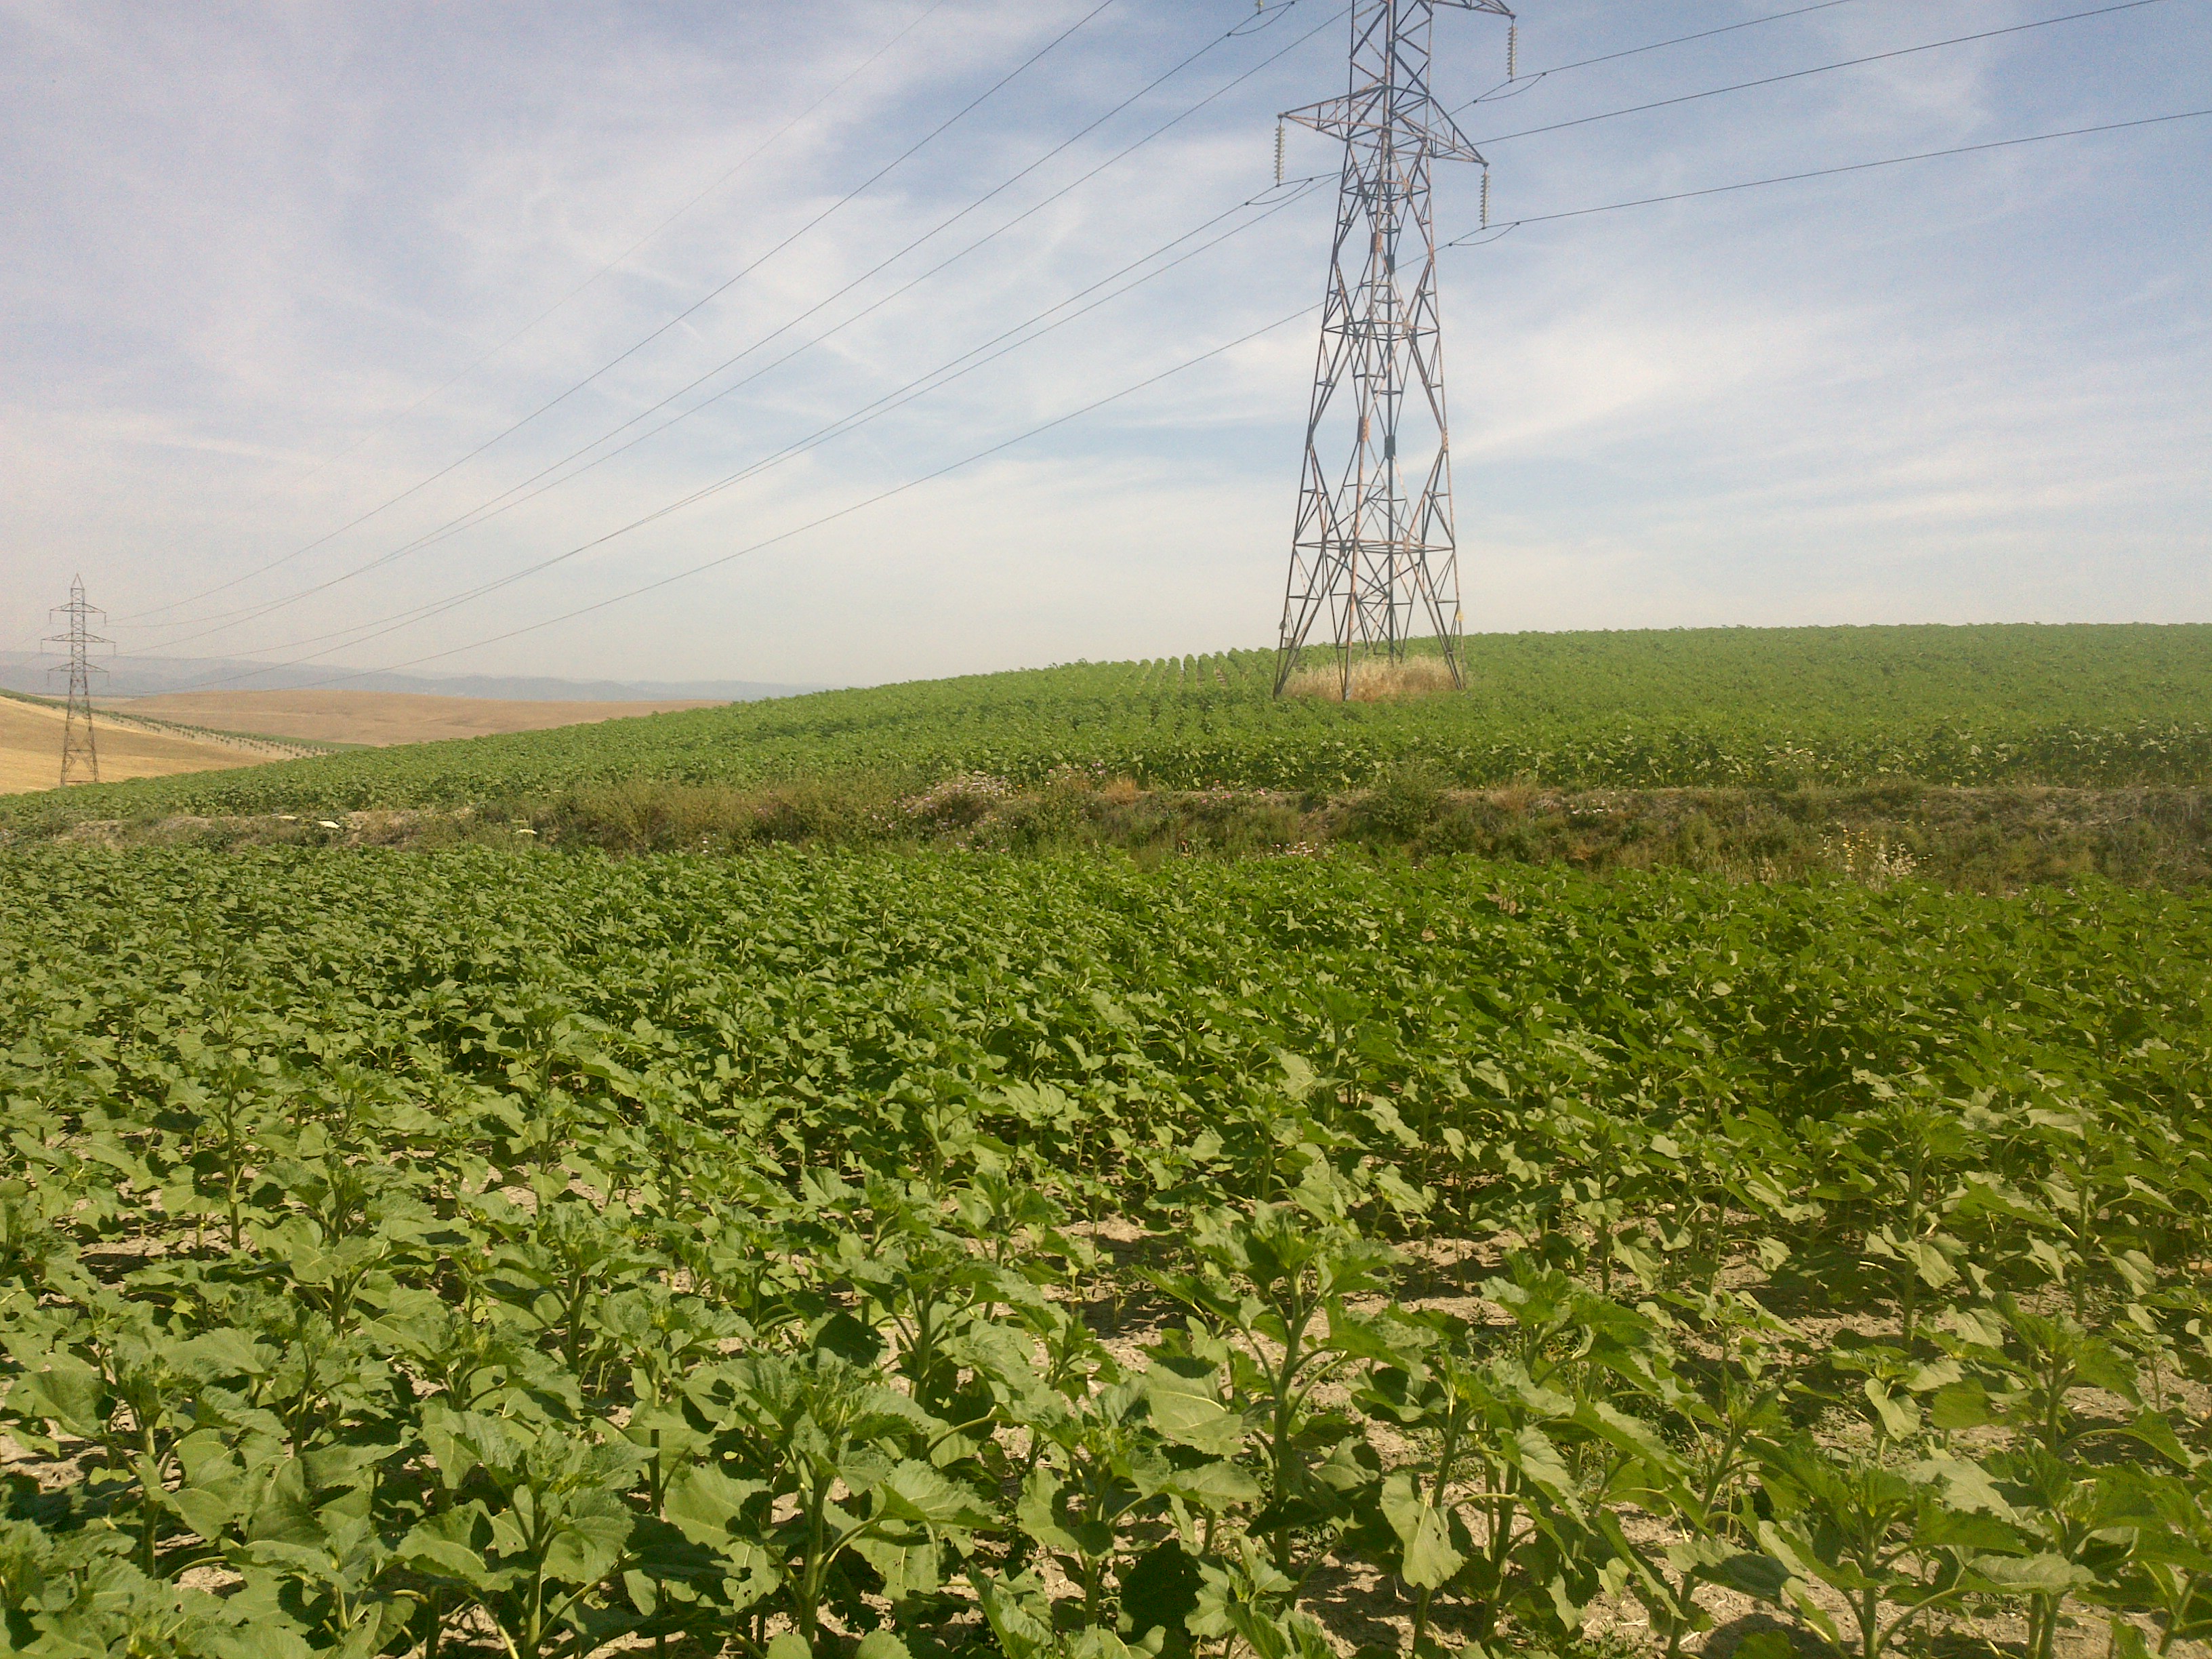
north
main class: Cropland
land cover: Sunflower
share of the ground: > 75 %
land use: Agriculture (excluding fallow land and kitchen gardens)
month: May
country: ES
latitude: 37.8193
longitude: -4.6548
